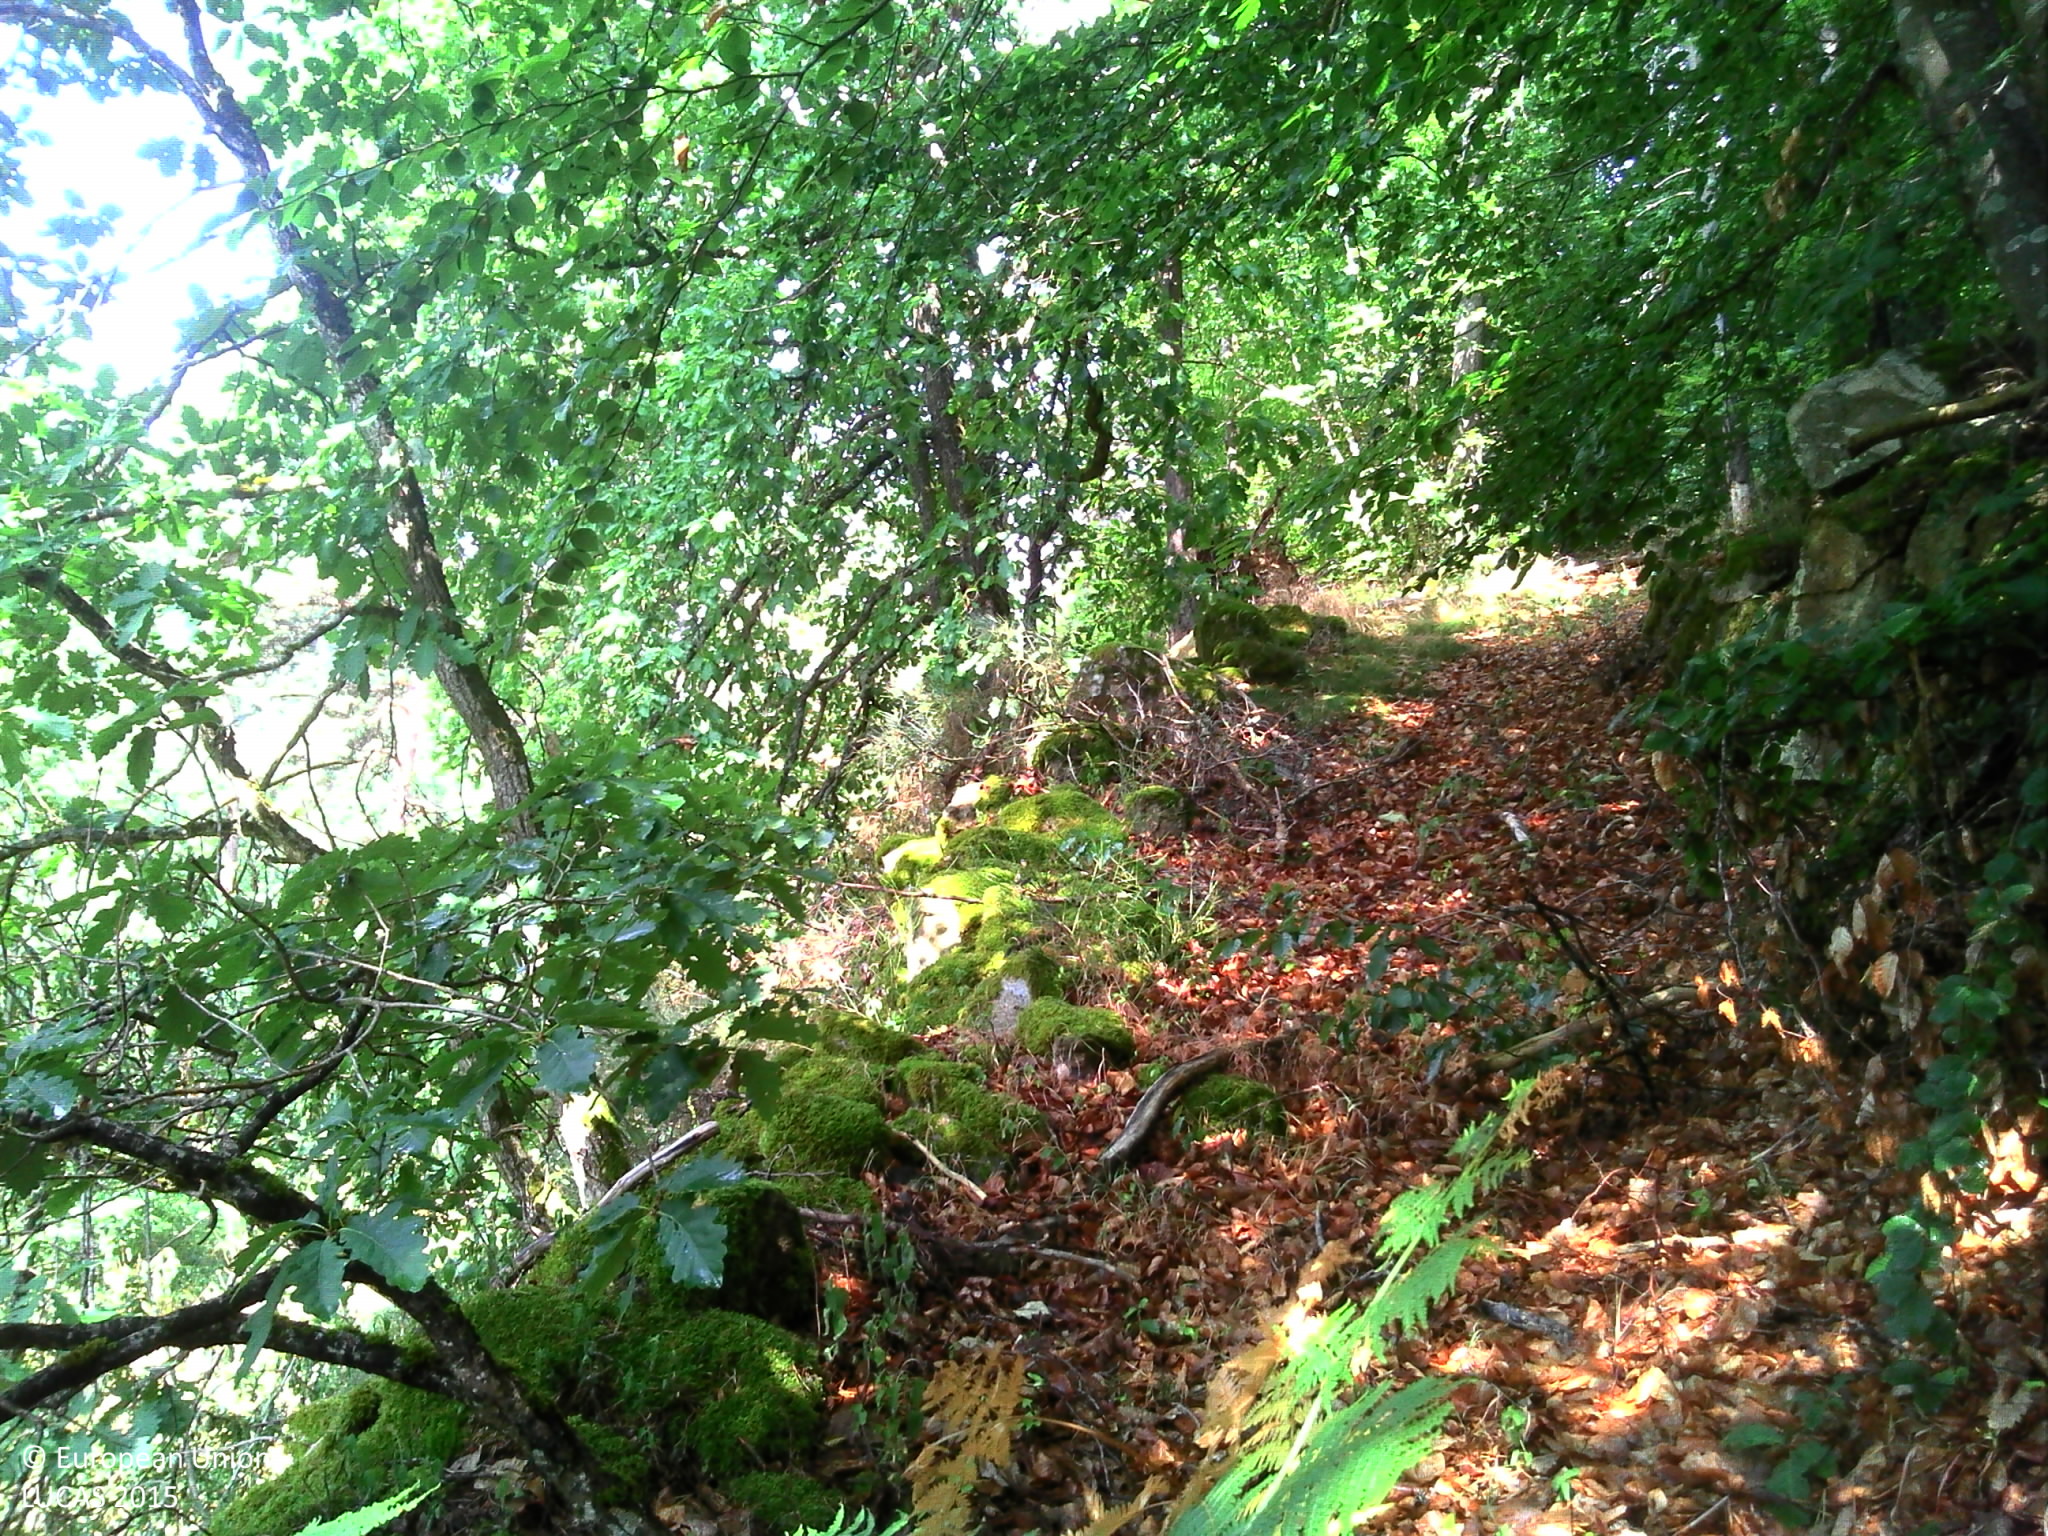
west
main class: Woodland
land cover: Pine dominated mixed woodland
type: mesophytic deciduous forest
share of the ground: > 75 %
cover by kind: broadleaved forest trees 65 %, coniferous forest trees 25 %, herbaceous plants 10 %
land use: Forestry
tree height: > 5 m
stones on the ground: < 10 %
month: July
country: FR
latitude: 45.1624
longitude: 4.1649
